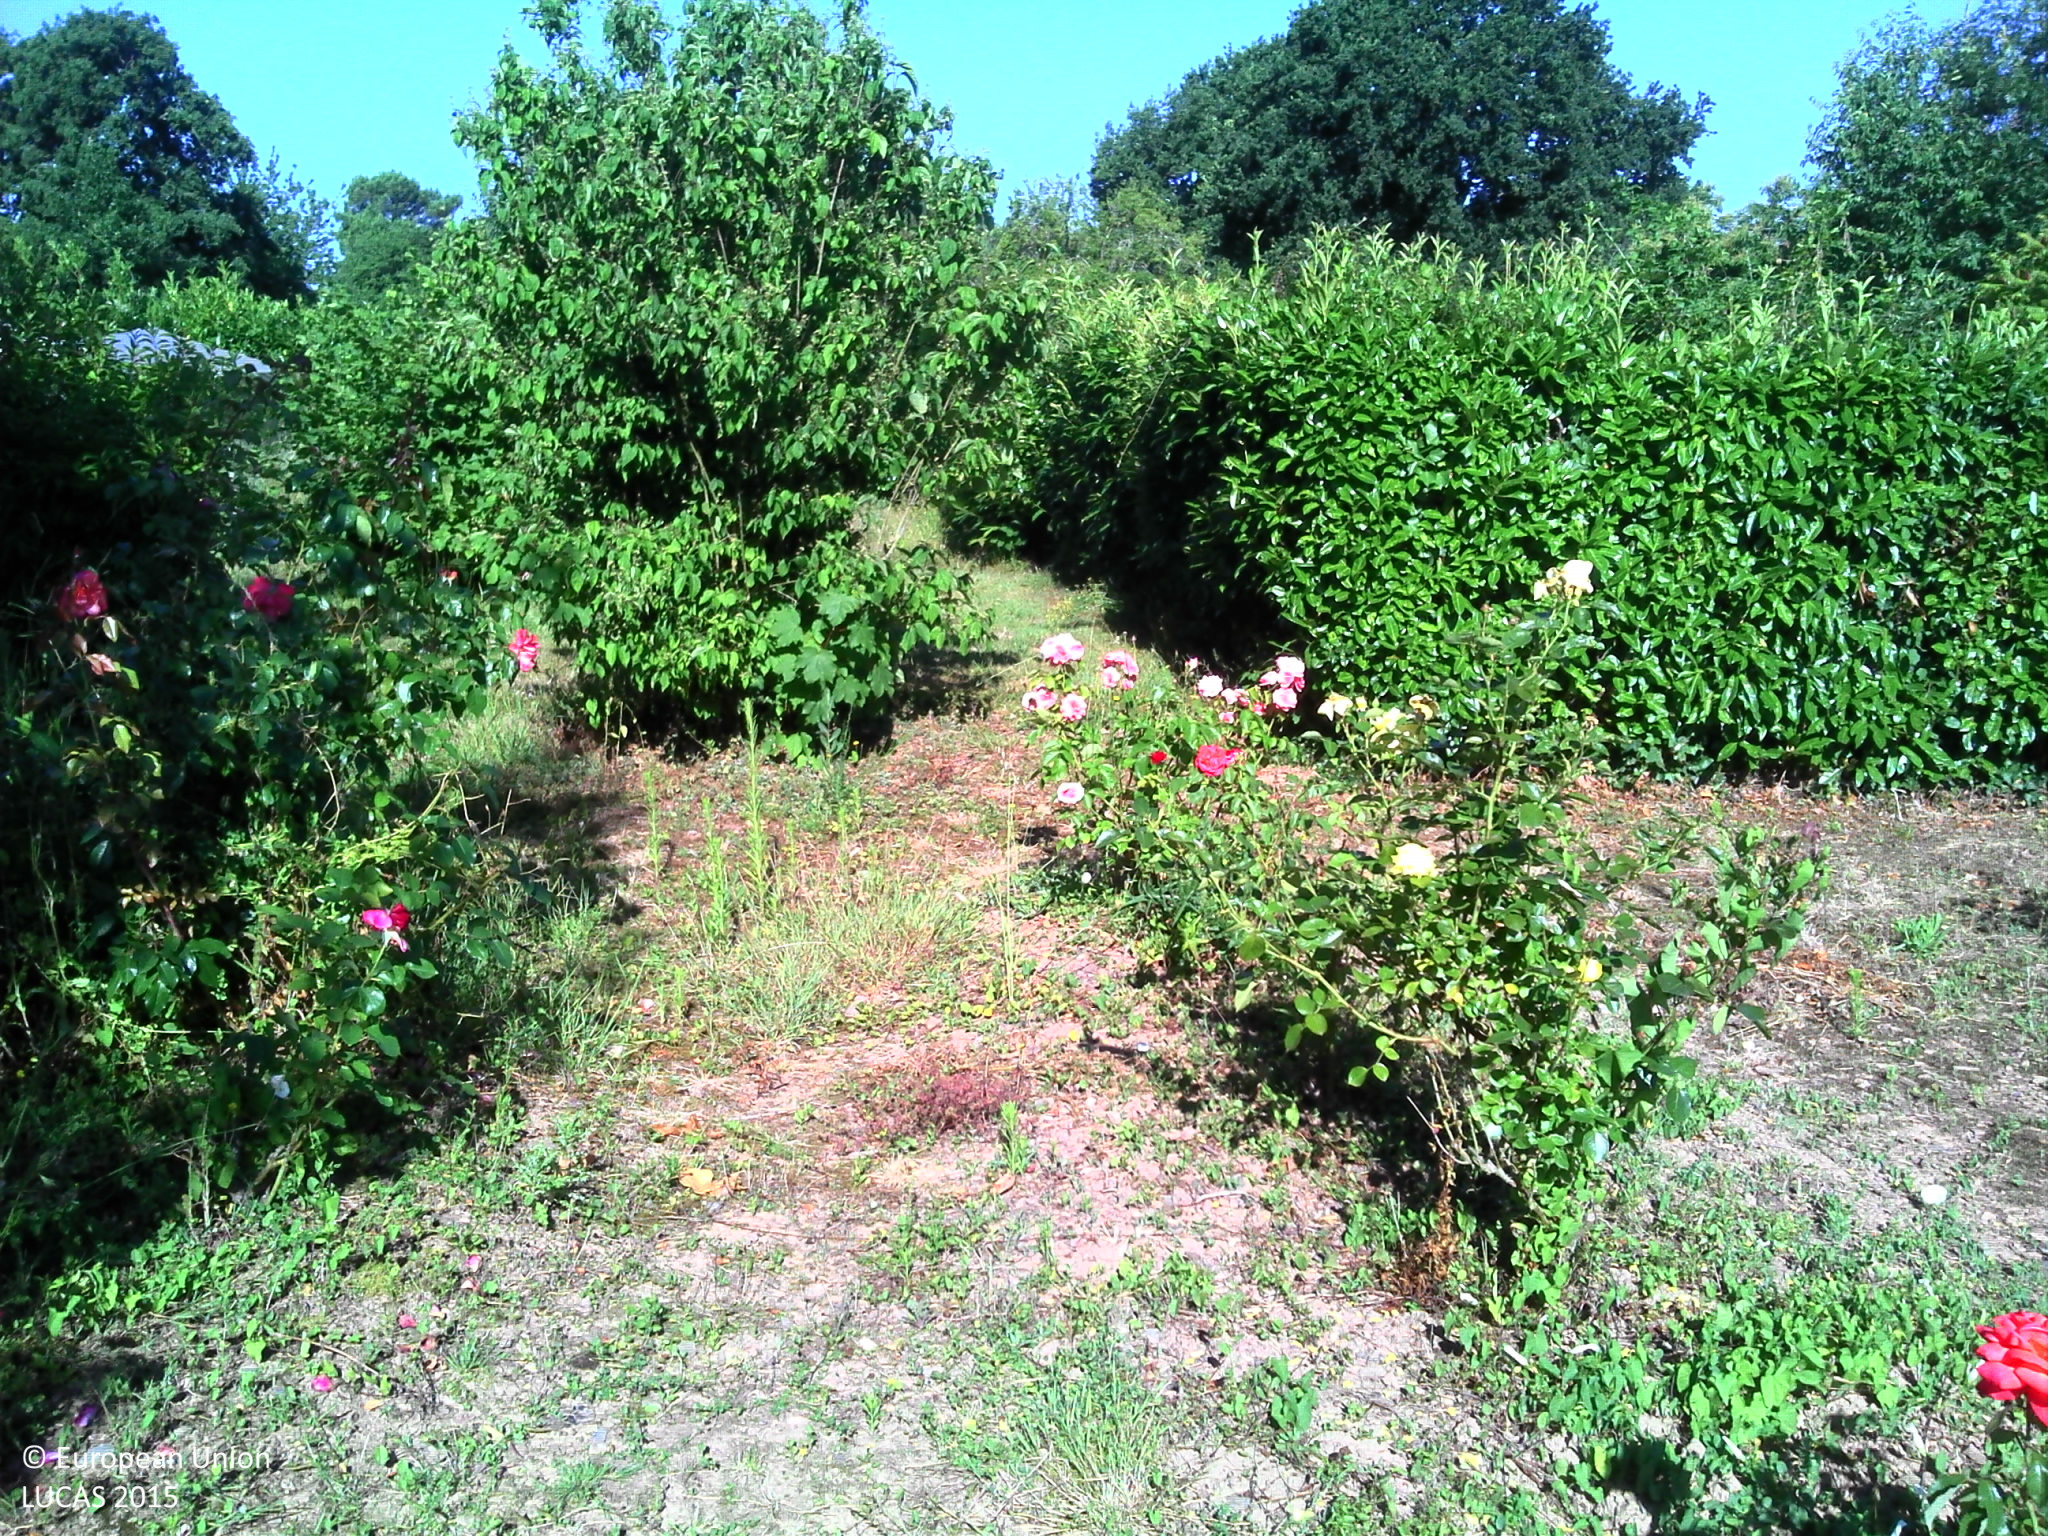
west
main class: Cropland
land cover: Floriculture and ornamental plants
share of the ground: < 10 %
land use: Kitchen garden
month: July
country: FR
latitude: 47.6570
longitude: -1.9937
